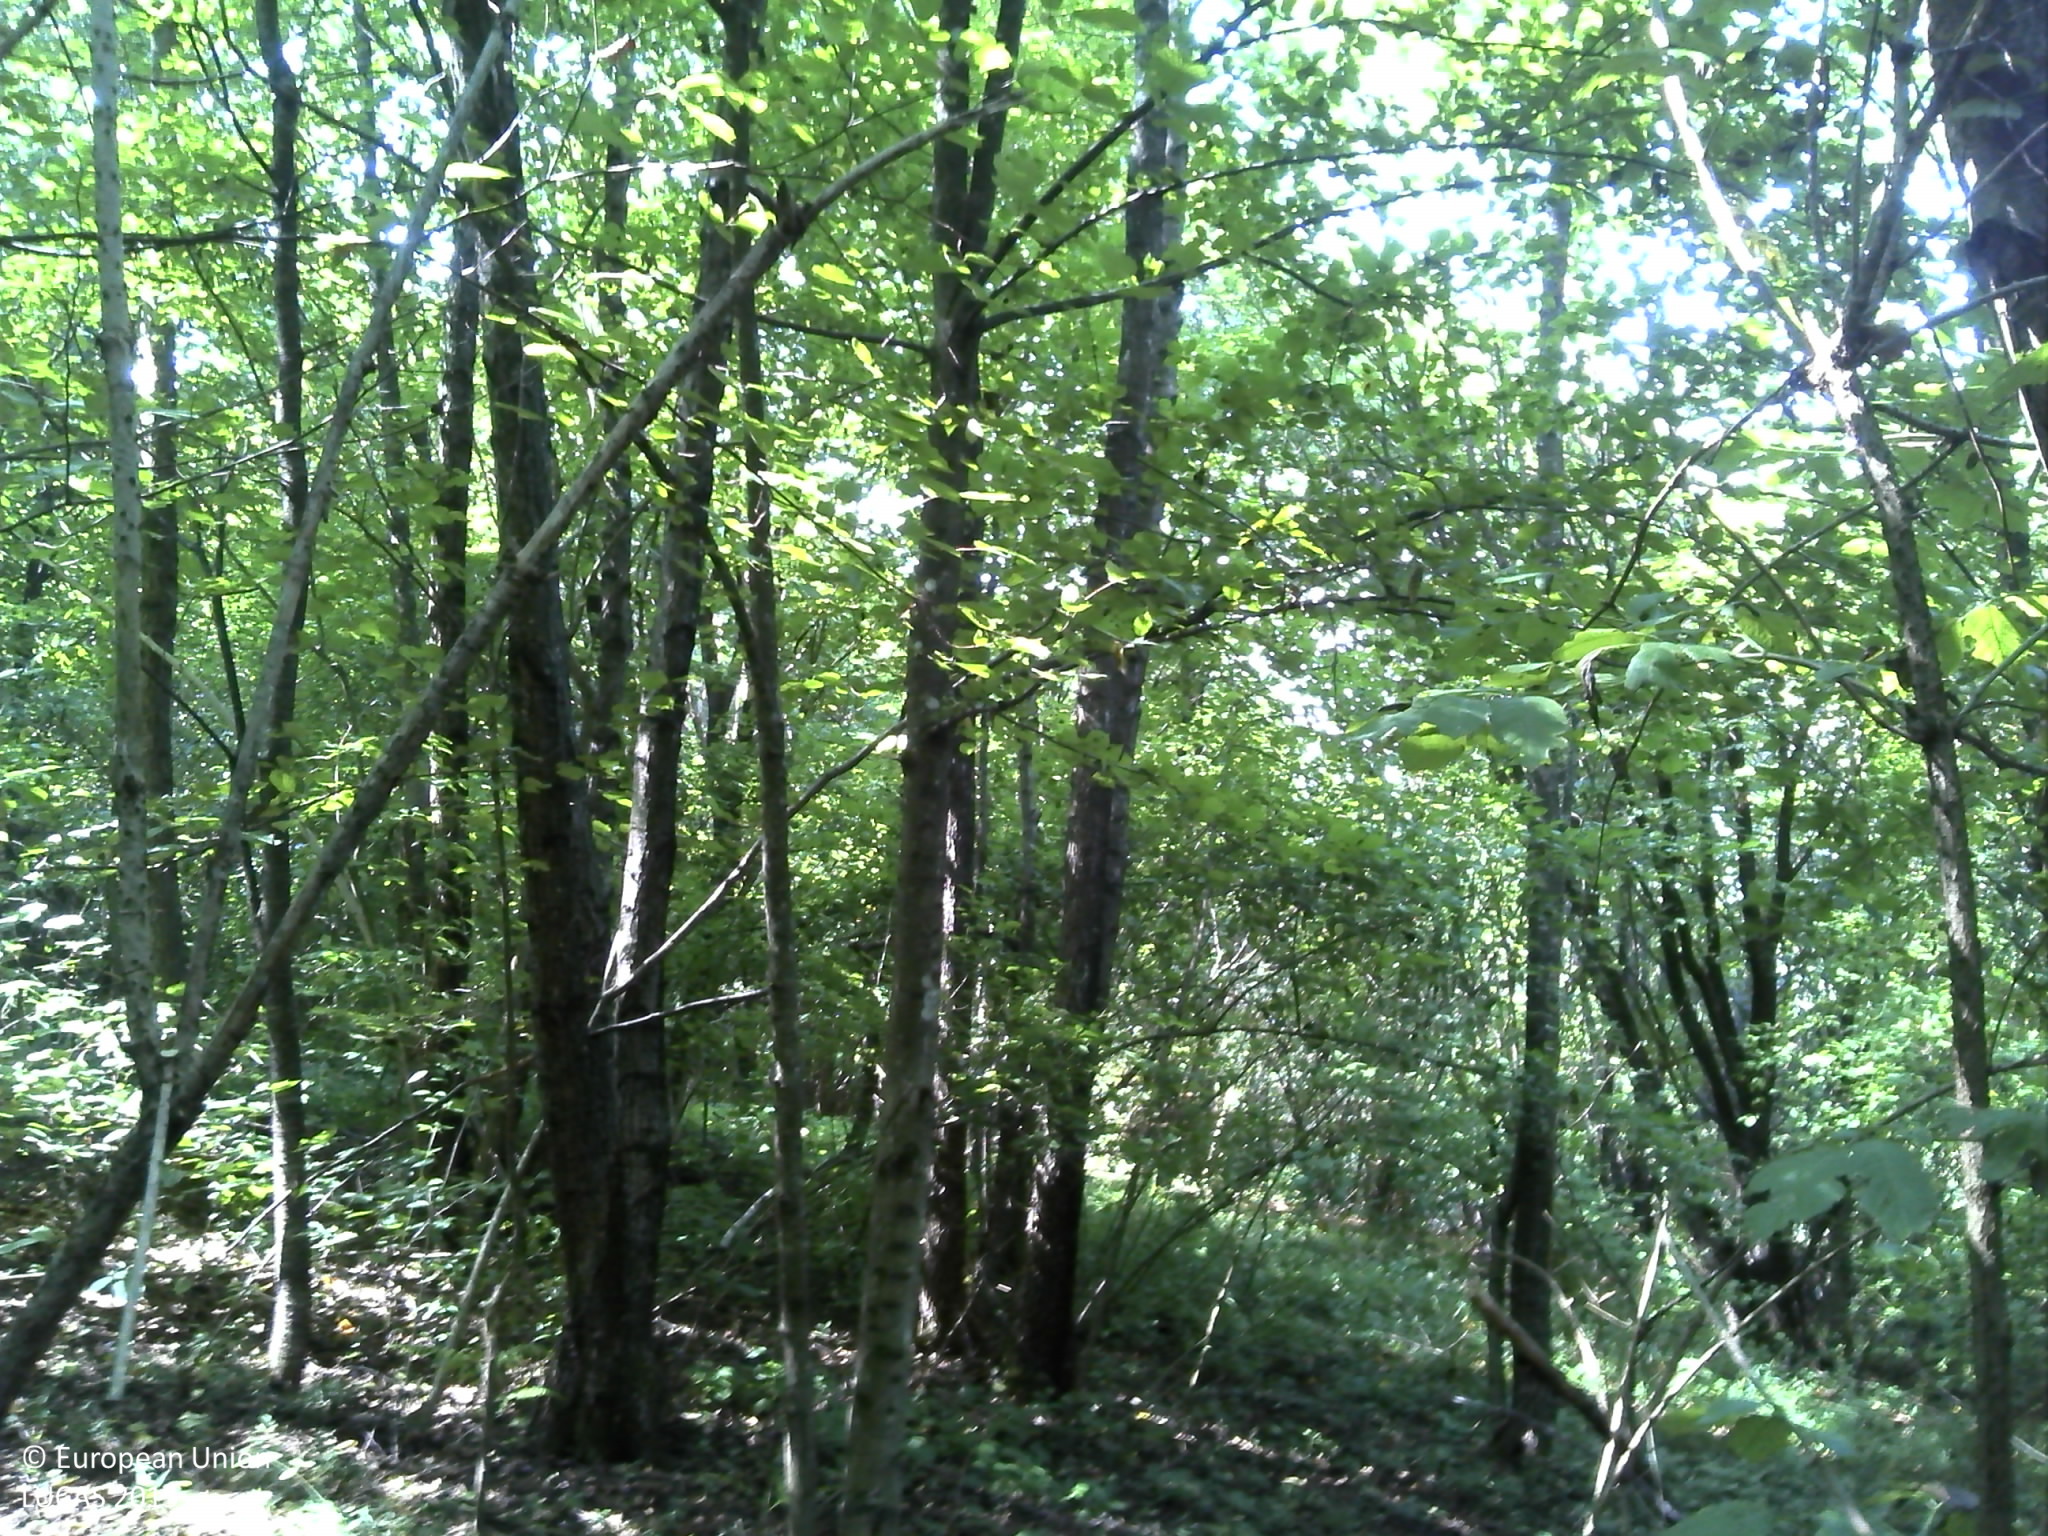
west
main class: Woodland
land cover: Broadleaved woodland
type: thermophilous deciduous forest
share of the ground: > 75 %
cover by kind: broadleaved forest trees 100 %
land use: Forestry
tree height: > 5 m
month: August
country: HR
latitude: 45.3310
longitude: 15.7251
